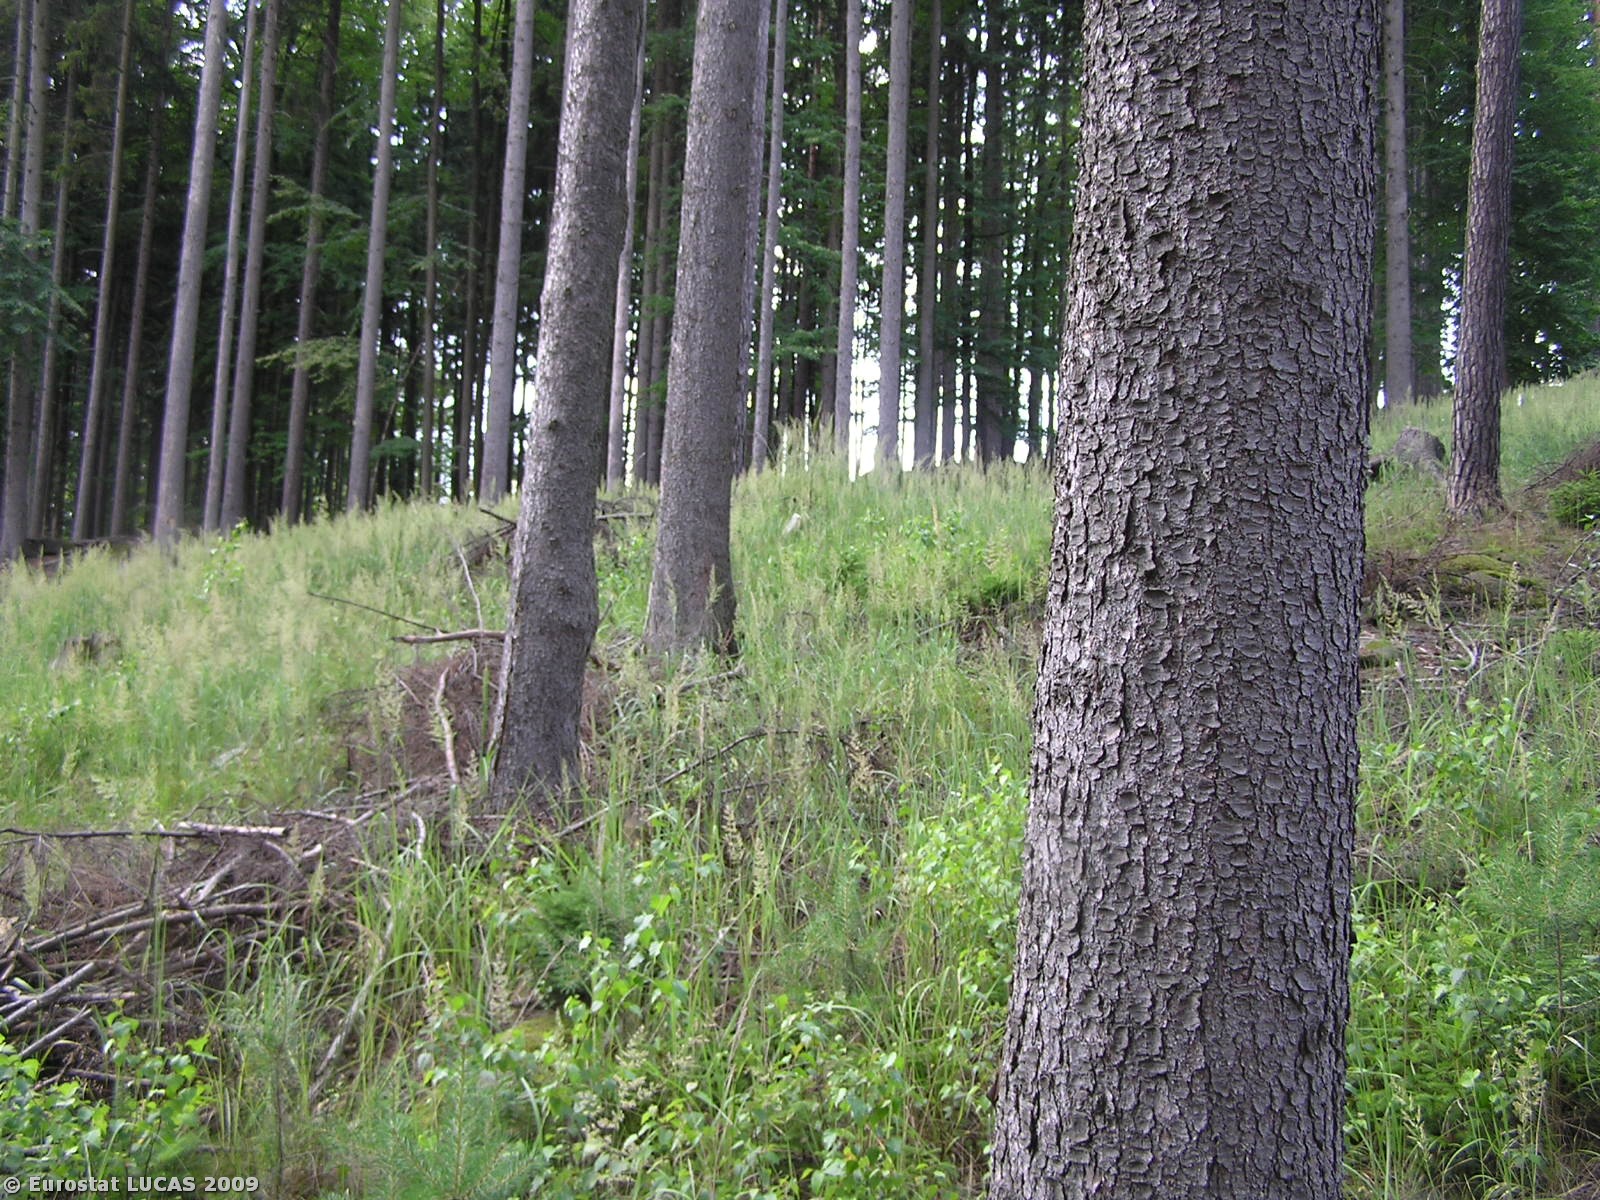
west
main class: Woodland
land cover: Coniferous woodland
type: hemiboreal forest and nemoral coniferous forest and mixed broadleaved-coniferous forest
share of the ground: > 75 %
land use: Forestry
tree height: > 5 m
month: July
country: CZ
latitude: 50.3380
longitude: 17.1623
